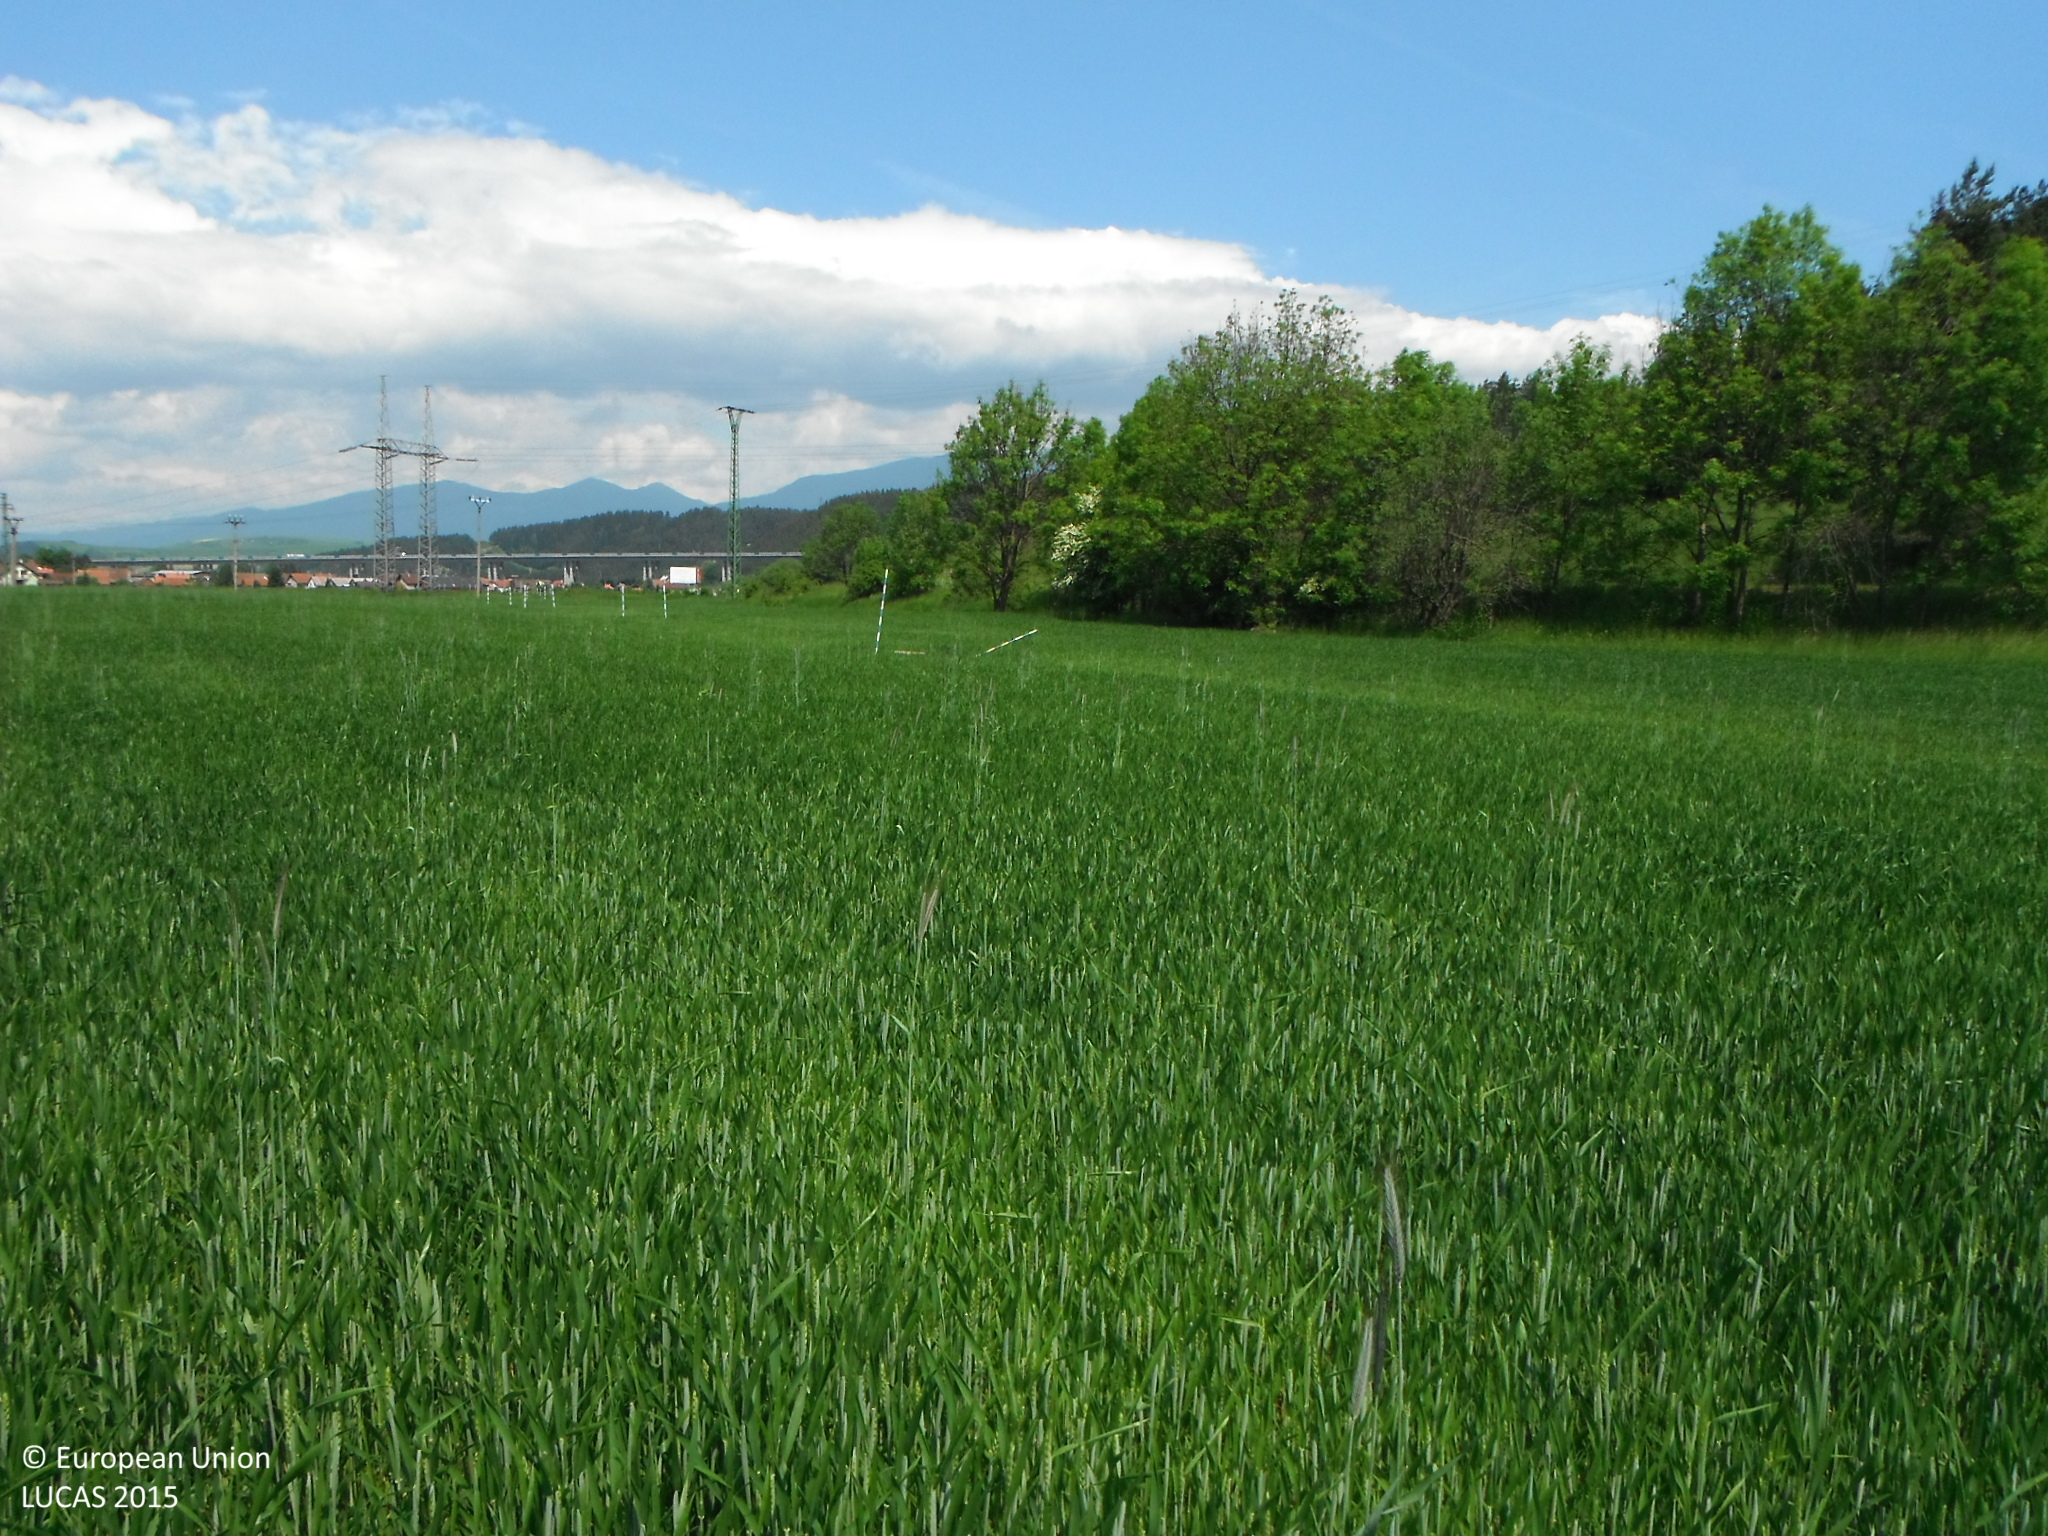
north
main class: Cropland
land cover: Common wheat
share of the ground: > 75 %
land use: Agriculture (excluding fallow land and kitchen gardens)
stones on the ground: > 50 %
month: June
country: SK
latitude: 49.0451
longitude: 19.7005
